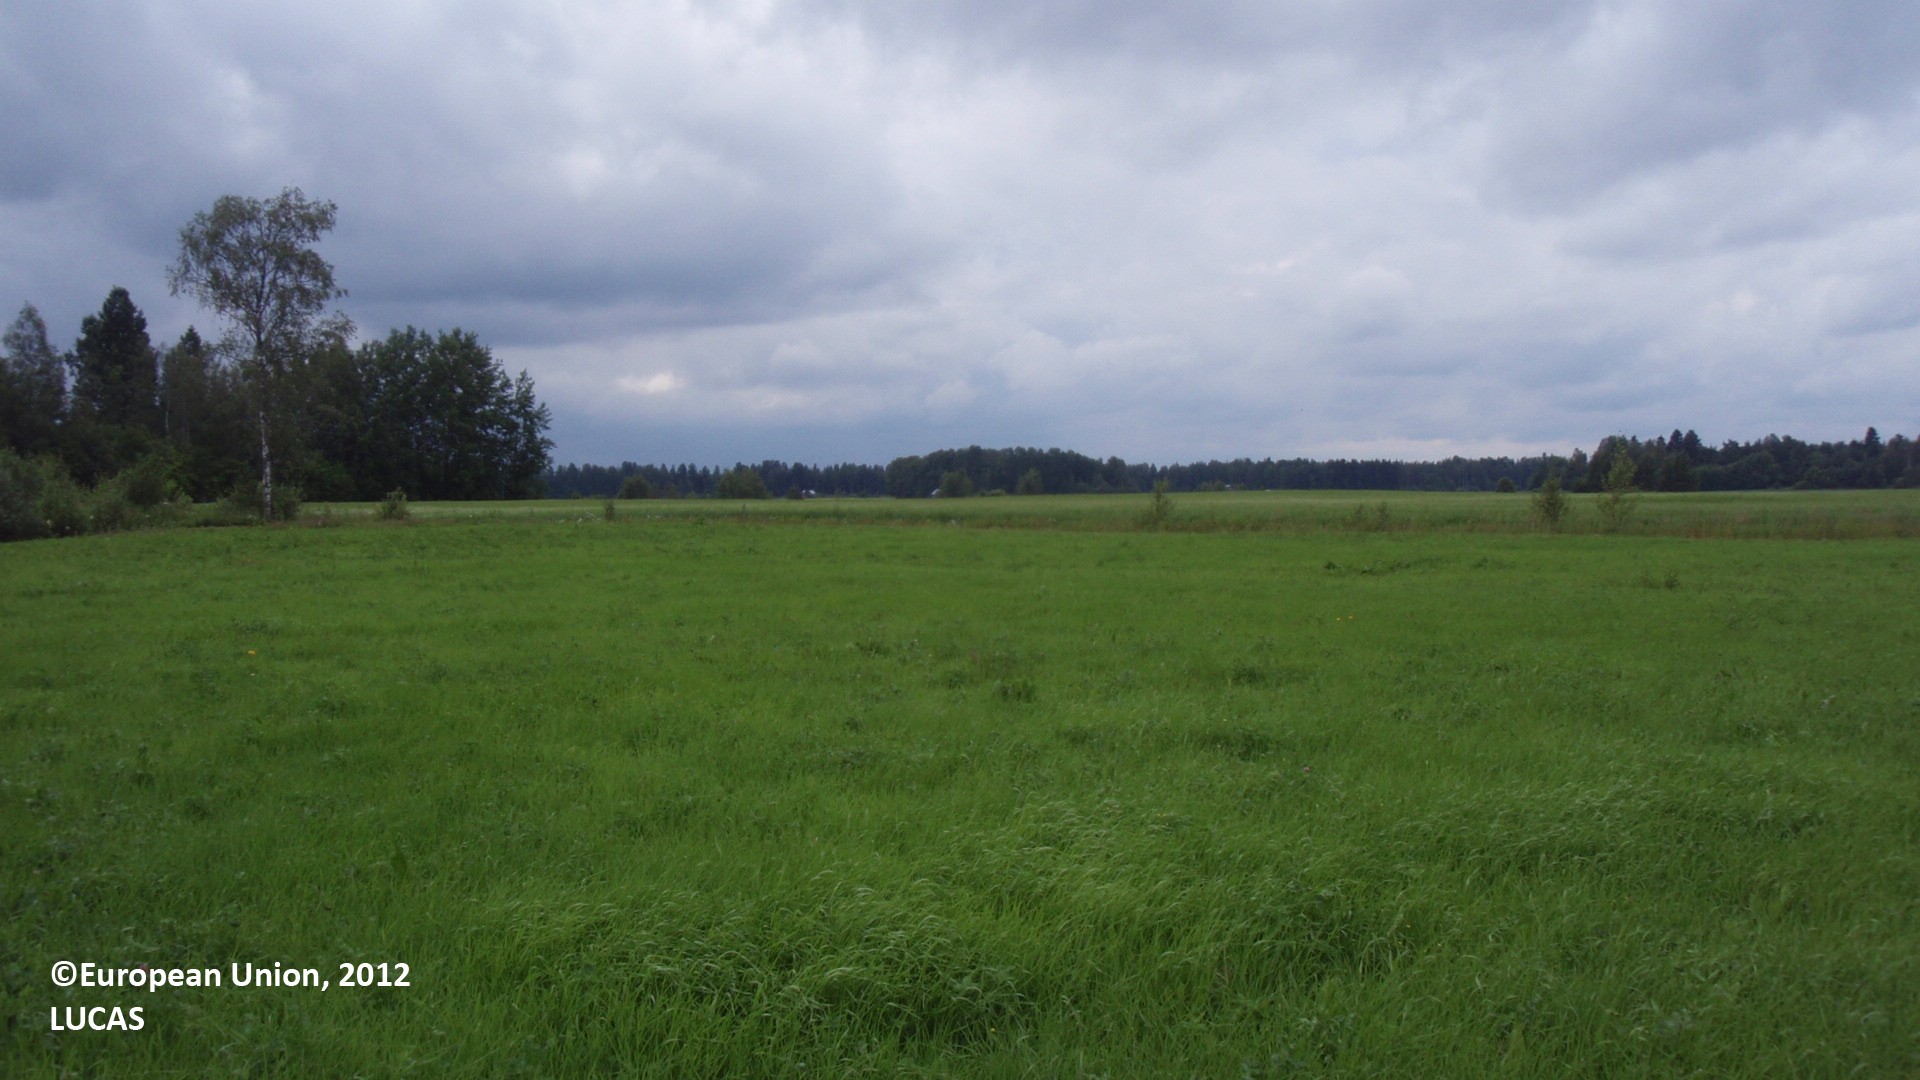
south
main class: Cropland
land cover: Temporary grasslands
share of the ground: > 75 %
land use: Agriculture (excluding fallow land and kitchen gardens)
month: July
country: FI
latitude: 61.0578
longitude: 28.4999
